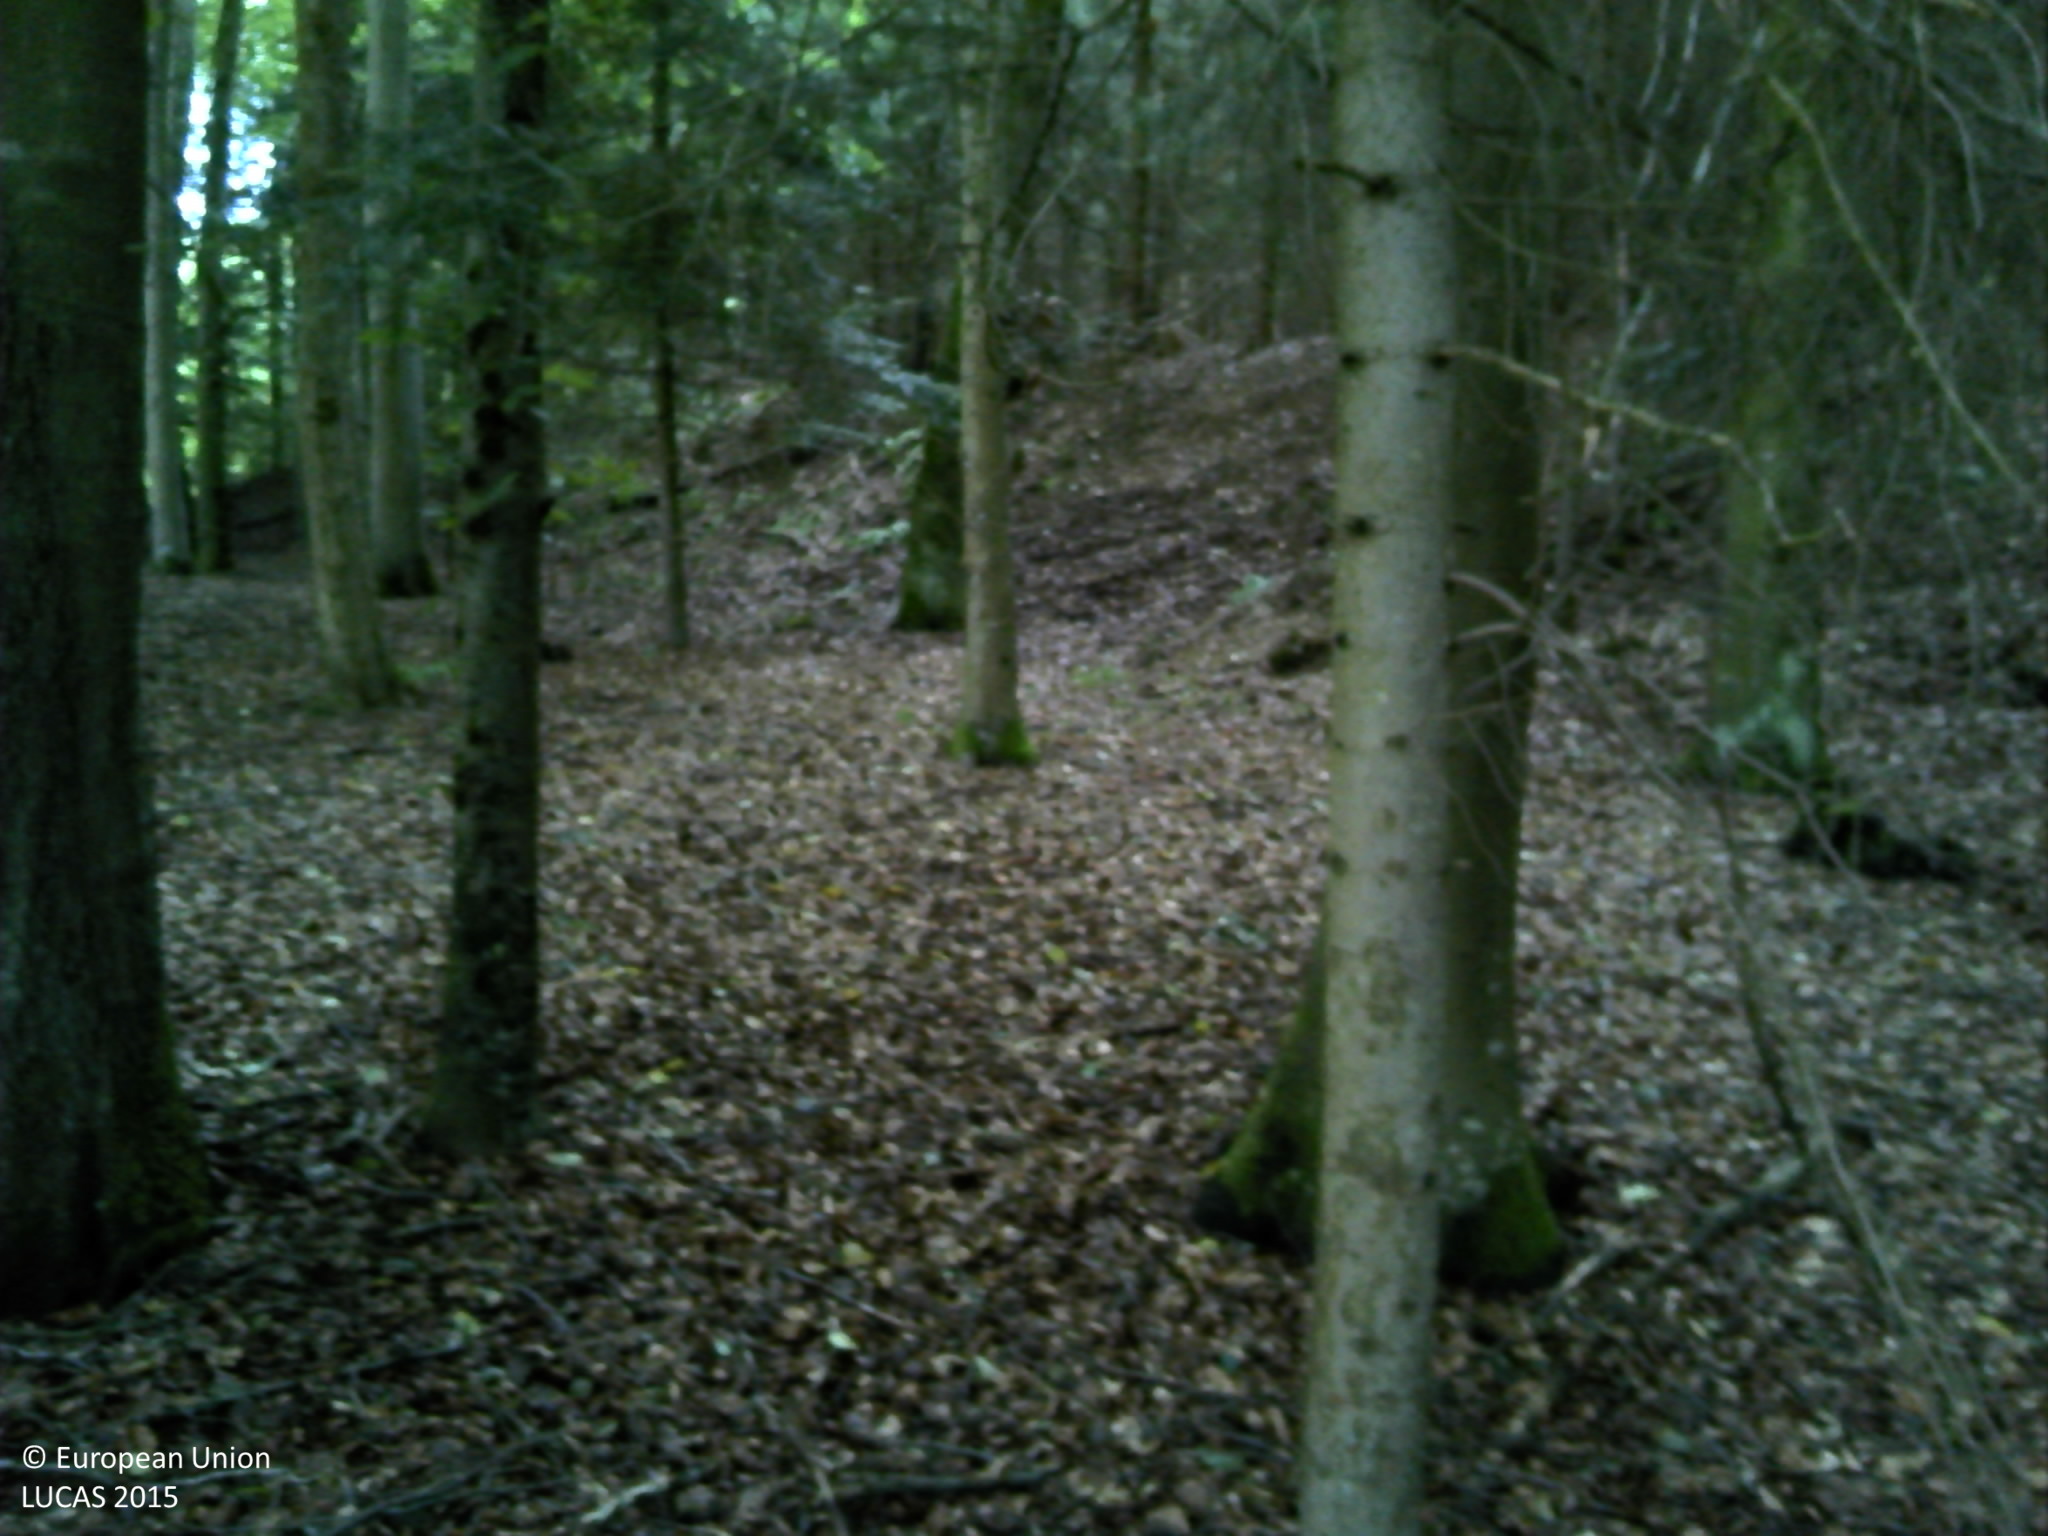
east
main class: Woodland
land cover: Spruce dominated mixed woodland
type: alpine coniferous forest
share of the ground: > 75 %
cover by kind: broadleaved forest trees 60 %, coniferous forest trees 40 %
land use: Forestry
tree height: > 5 m
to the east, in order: Spruce dominated mixed woodland; Spruce dominated coniferous woodland; Spruce dominated mixed woodland; Grass margins; Tracks; Grass margins; Fences; Clovers; Grassland with sparse tree/shrub cover; Clovers
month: July
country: FR
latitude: 48.1163
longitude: 6.5755
